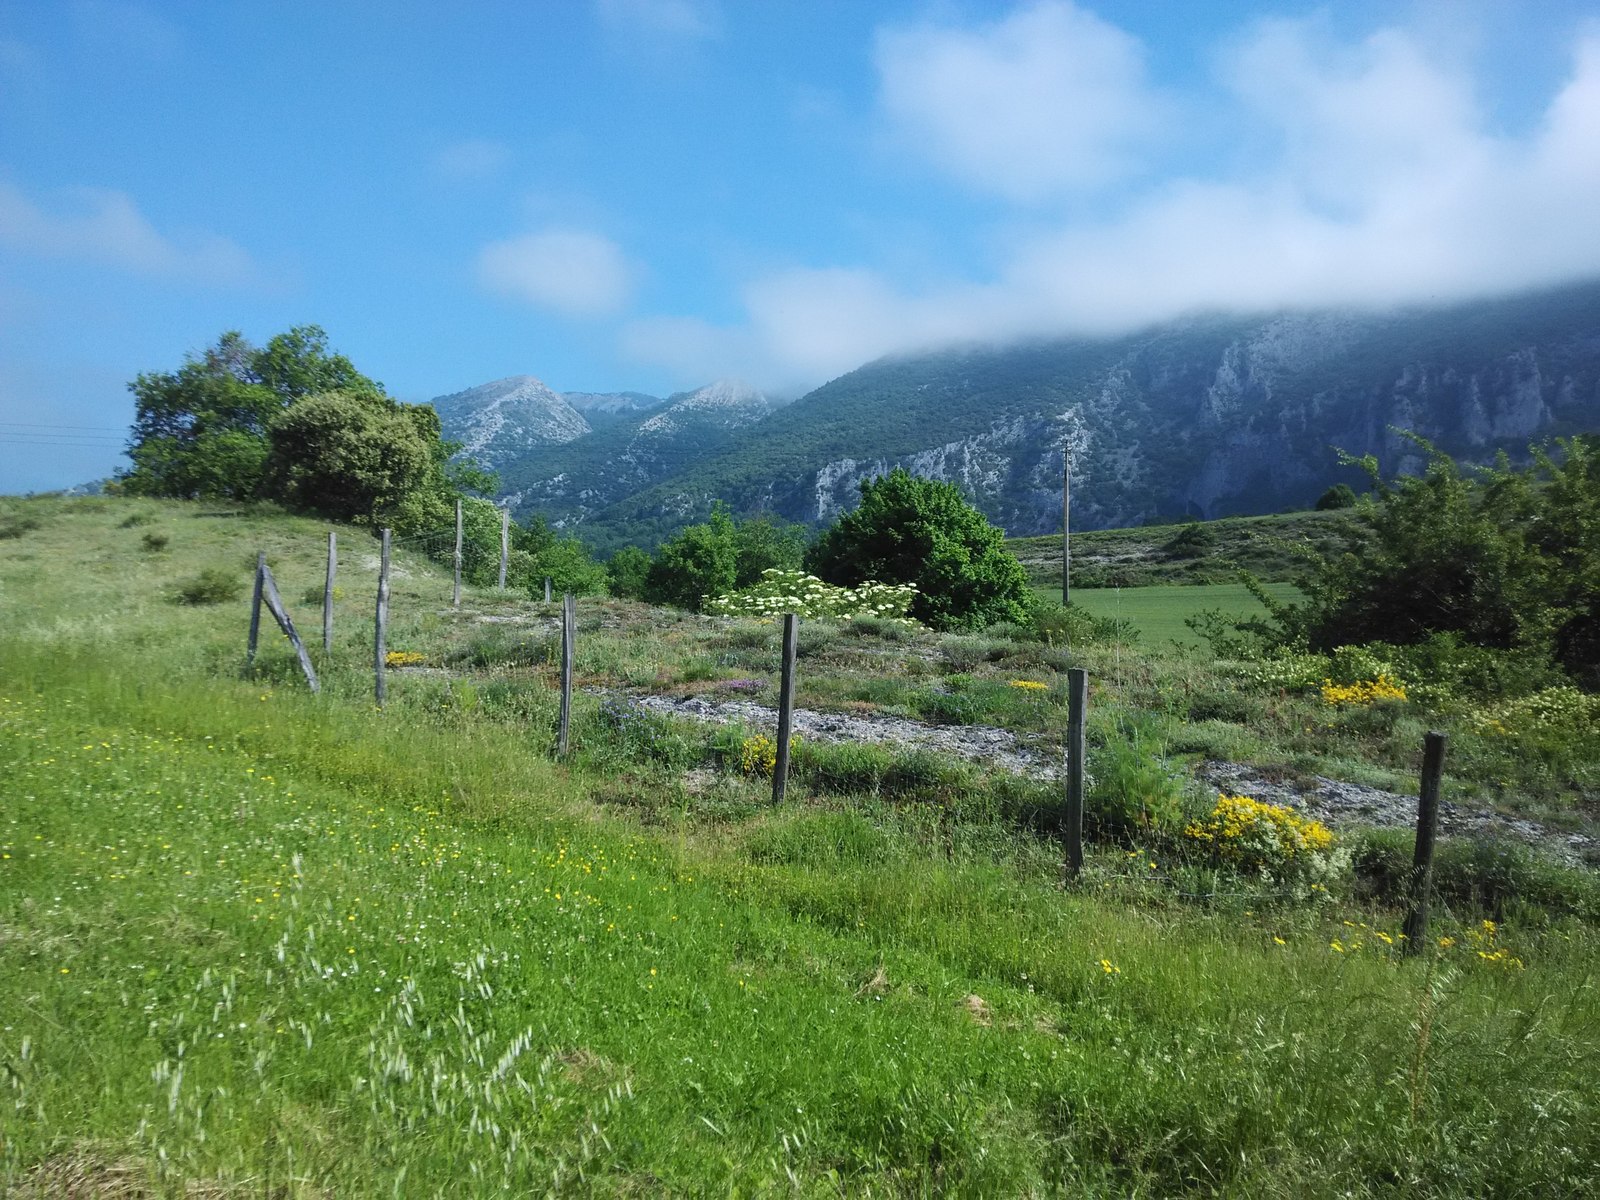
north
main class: Grassland
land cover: Grassland with sparse tree/shrub cover
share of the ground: 25 - 50 %
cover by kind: consolidated bare surface 50 %, herbaceous plants 40 %, broadleaved forest trees 5 %, shrubs 5 %
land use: Agriculture (excluding fallow land and kitchen gardens)
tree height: < 5 m
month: June
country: ES
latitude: 42.8712
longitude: -2.2756
